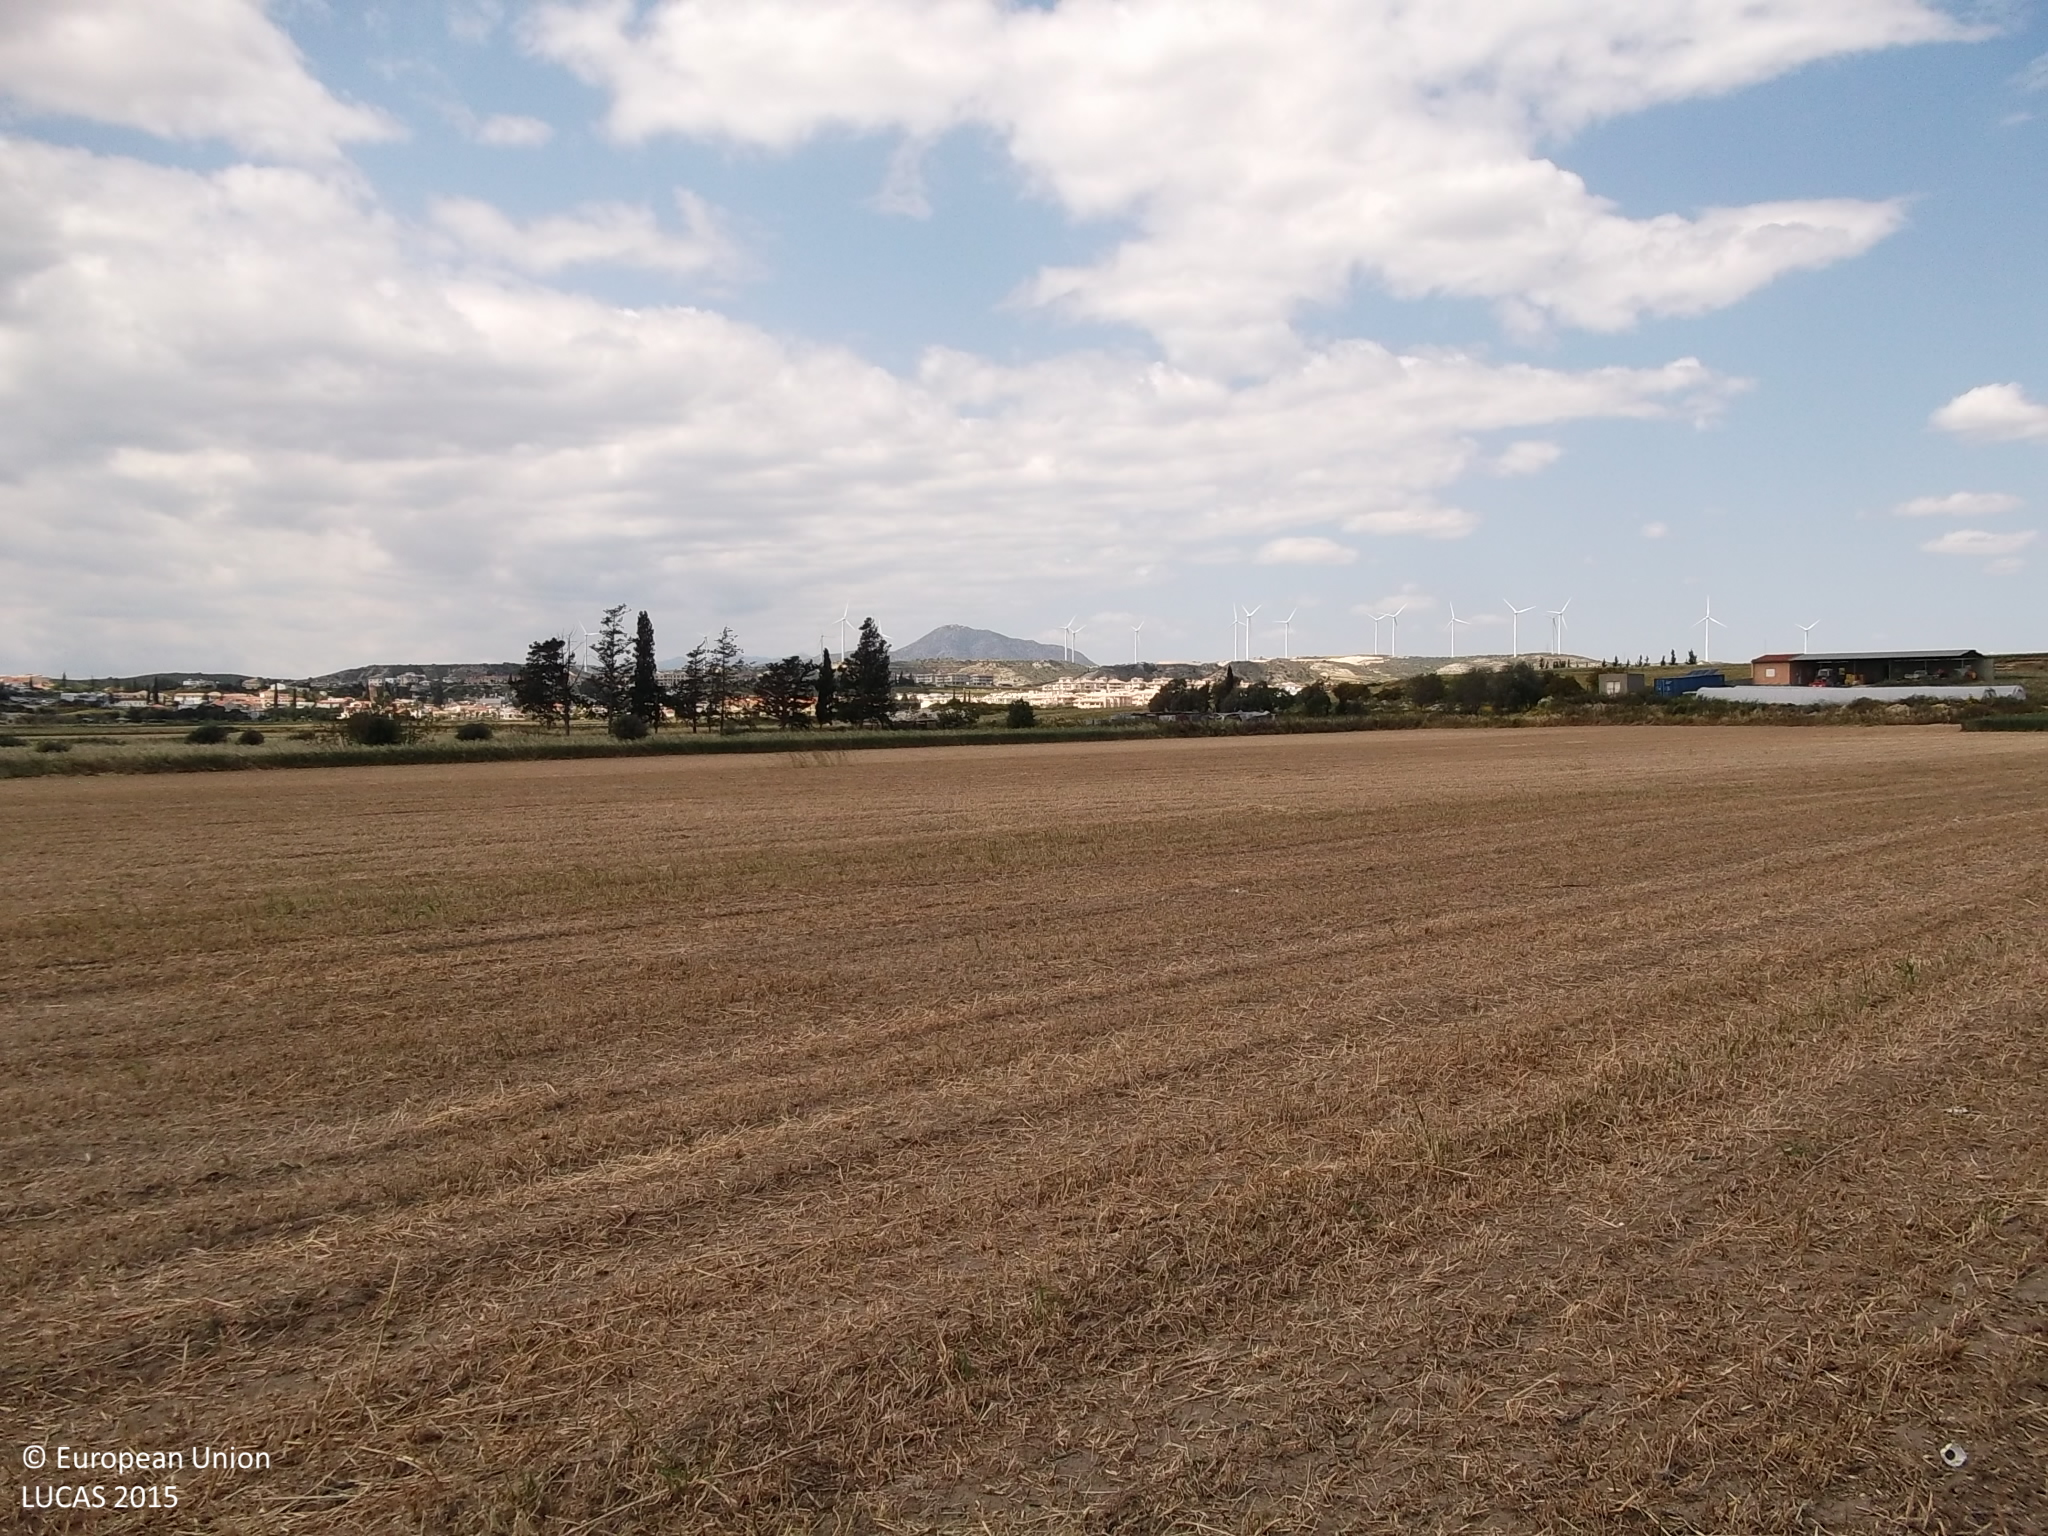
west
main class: Cropland
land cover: Common wheat
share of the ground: < 10 %
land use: Agriculture (excluding fallow land and kitchen gardens)
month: April
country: CY
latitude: 34.8541
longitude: 33.5648
